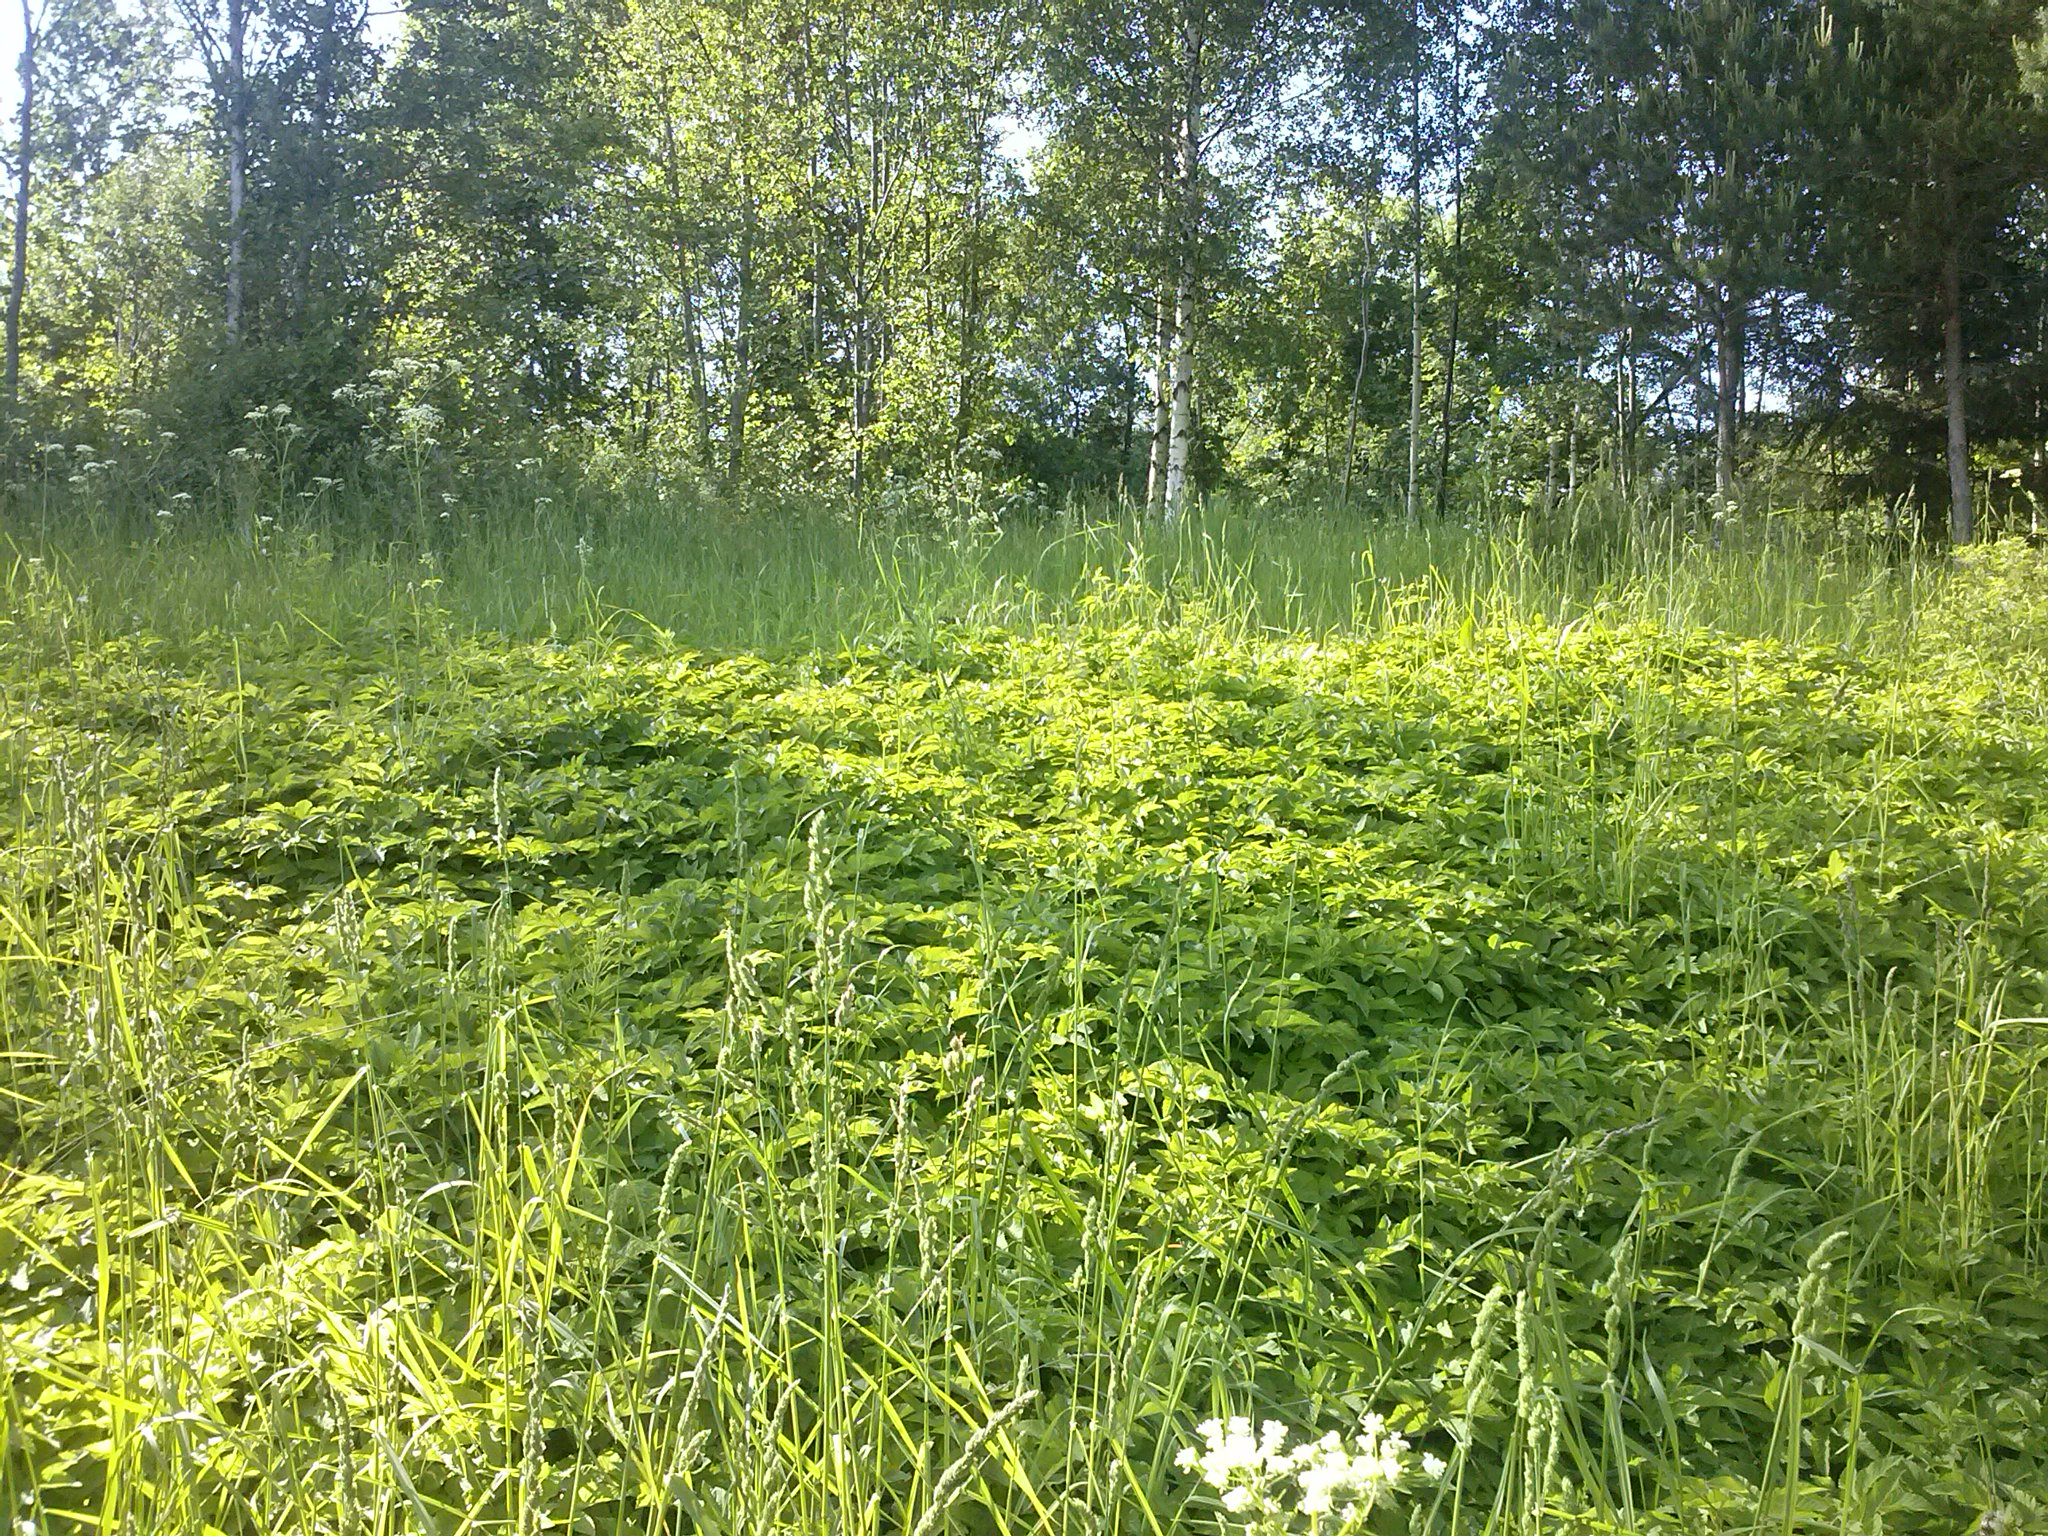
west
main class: Grassland
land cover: Grassland with sparse tree/shrub cover
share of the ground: > 75 %
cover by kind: herbaceous plants 90 %, coniferous forest trees 5 %, shrubs 5 %
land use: Forestry
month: June
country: LV
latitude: 56.3530
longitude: 27.6461
